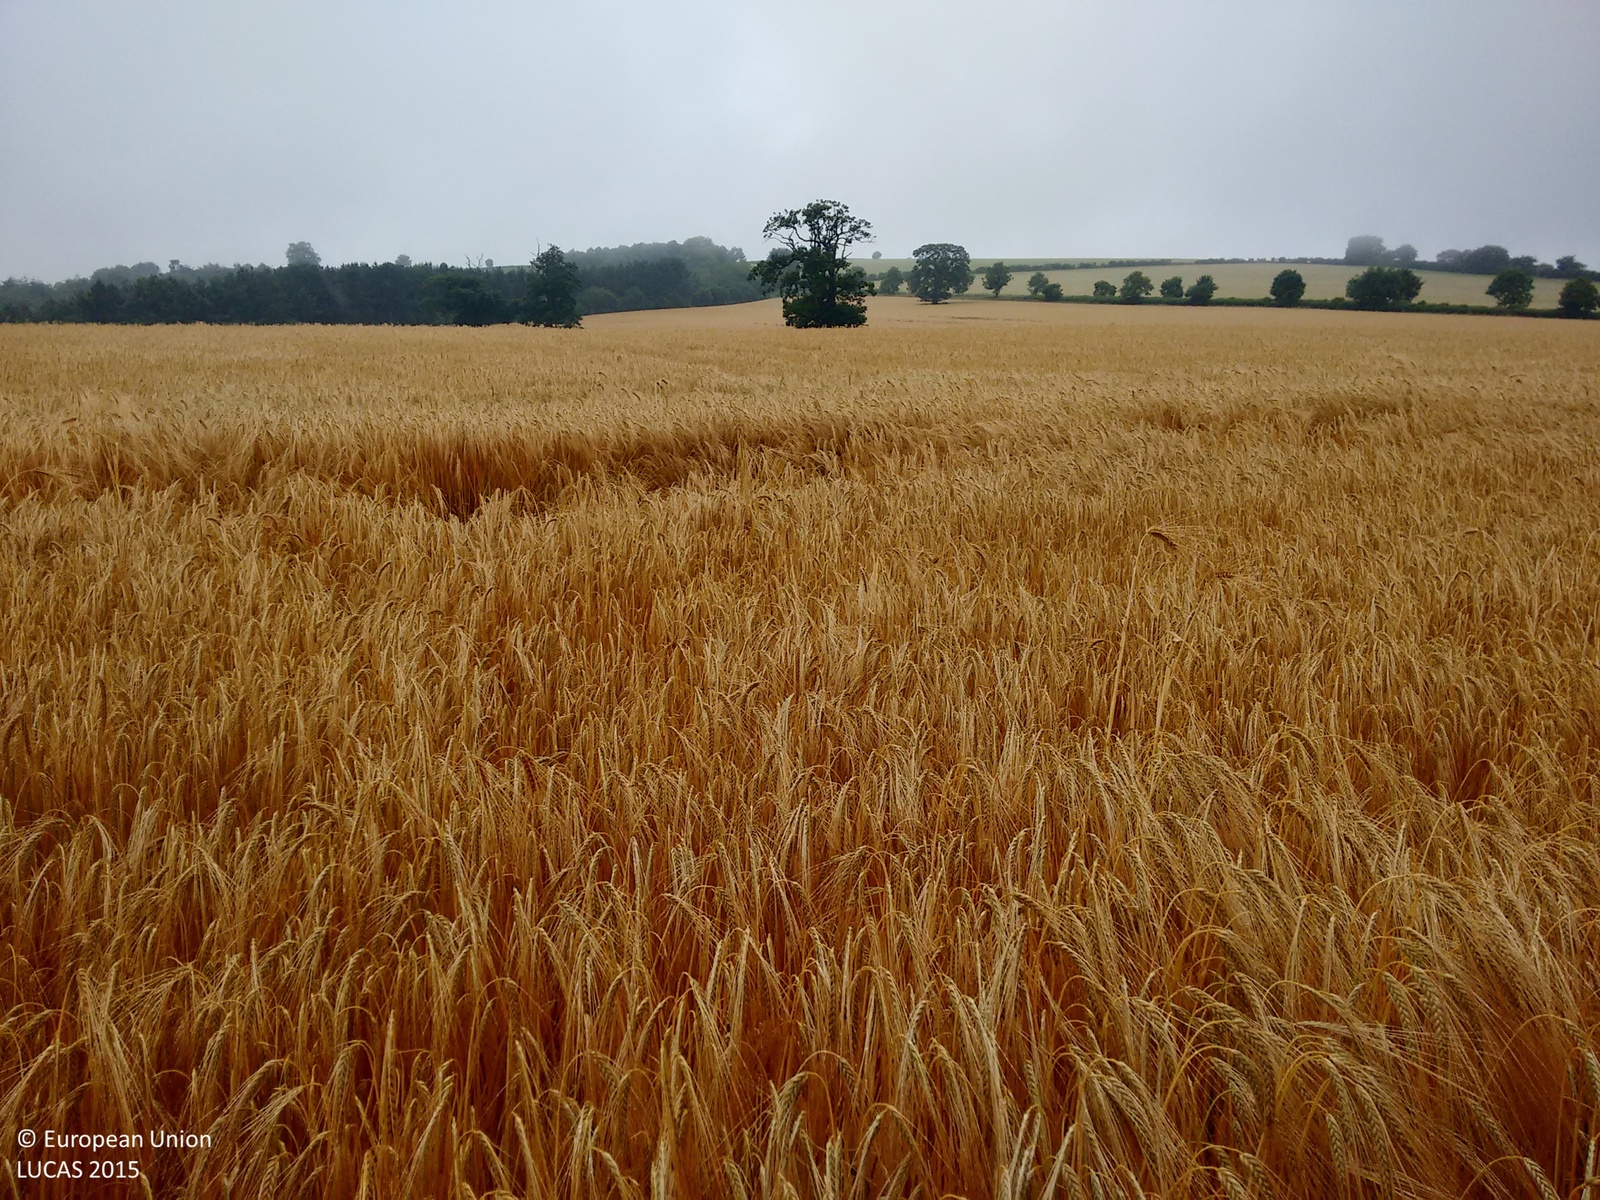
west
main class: Cropland
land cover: Barley
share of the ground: > 75 %
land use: Agriculture (excluding fallow land and kitchen gardens)
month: July
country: GB
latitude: 52.3691
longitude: -2.8352
